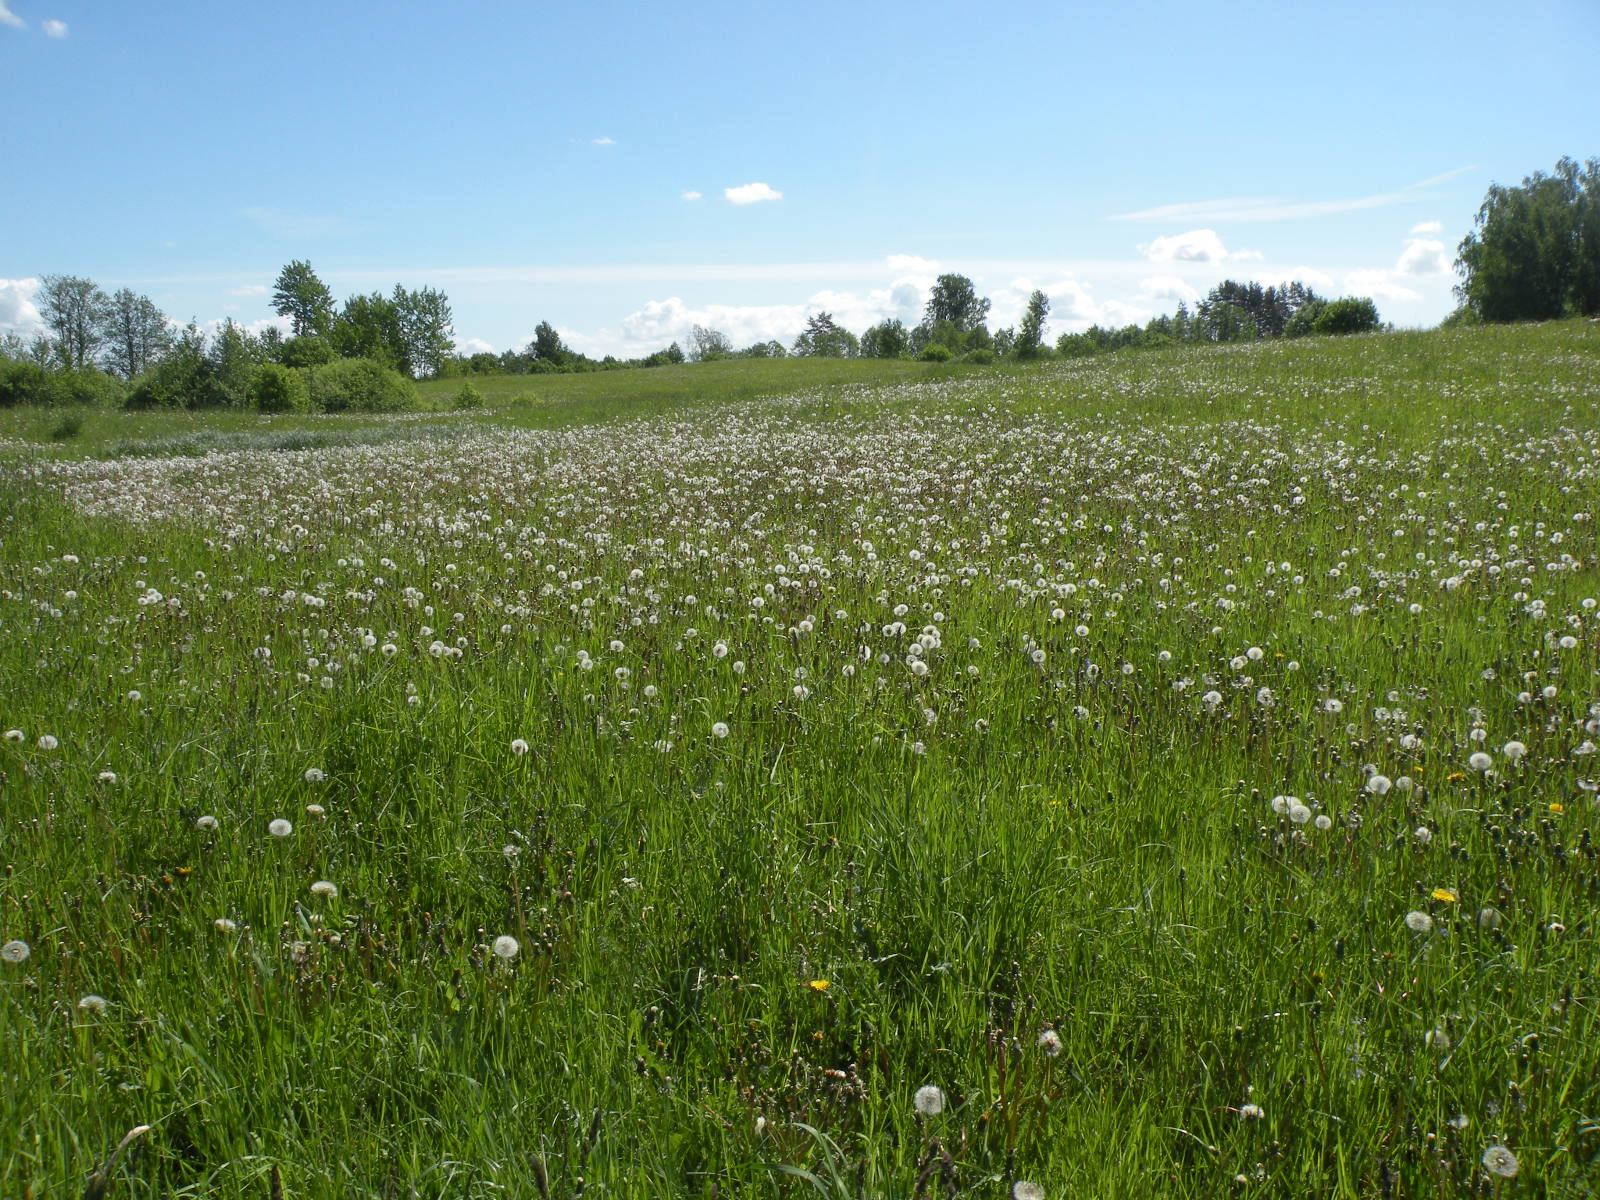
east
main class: Grassland
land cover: Grassland without tree/shrub cover
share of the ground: > 75 %
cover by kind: herbaceous plants 100 %
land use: Agriculture (excluding fallow land and kitchen gardens)
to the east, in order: Grassland without tree/shrub cover; Broadleaved woodland; Grassland without tree/shrub cover; Broadleaved woodland; Grassland without tree/shrub cover; Broadleaved woodland
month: May
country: LV
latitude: 56.0474
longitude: 26.2120
